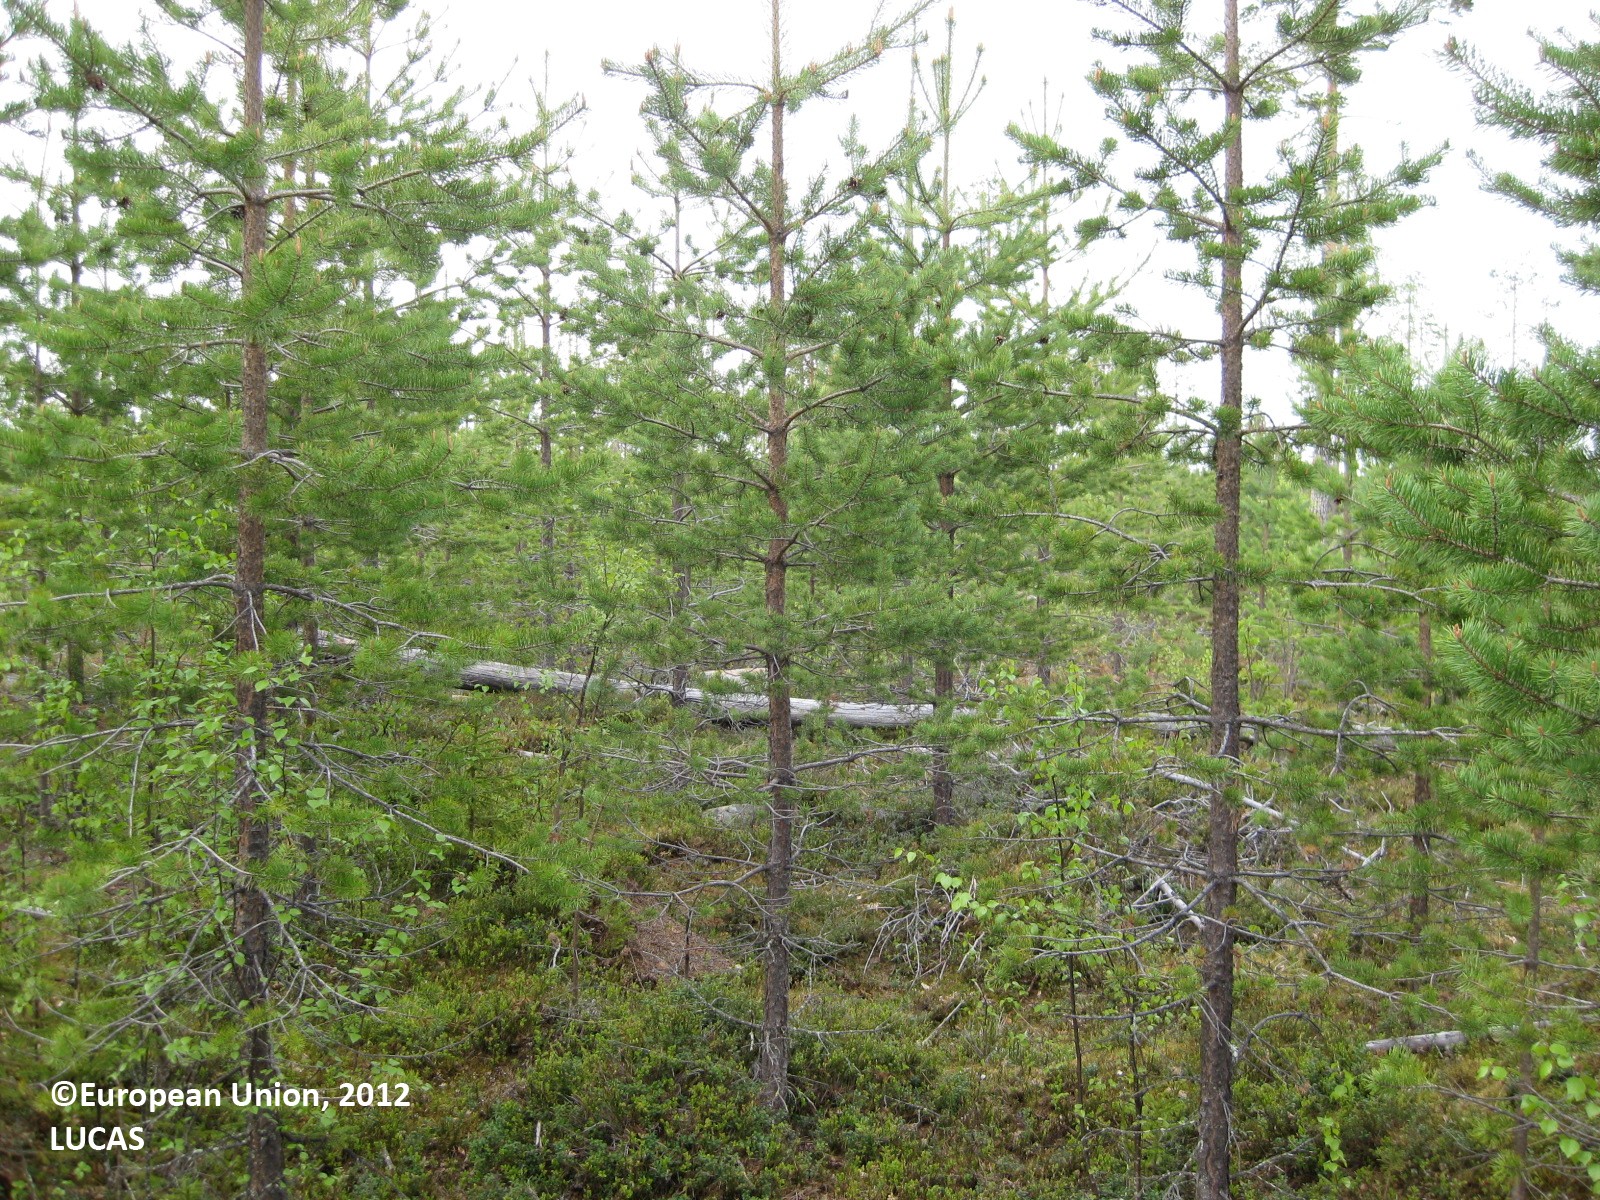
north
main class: Woodland
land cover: Pine dominated coniferous woodland
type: boreal forest
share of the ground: 50 - 75 %
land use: Forestry
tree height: < 5 m
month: June
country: FI
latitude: 65.3672
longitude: 29.3084
